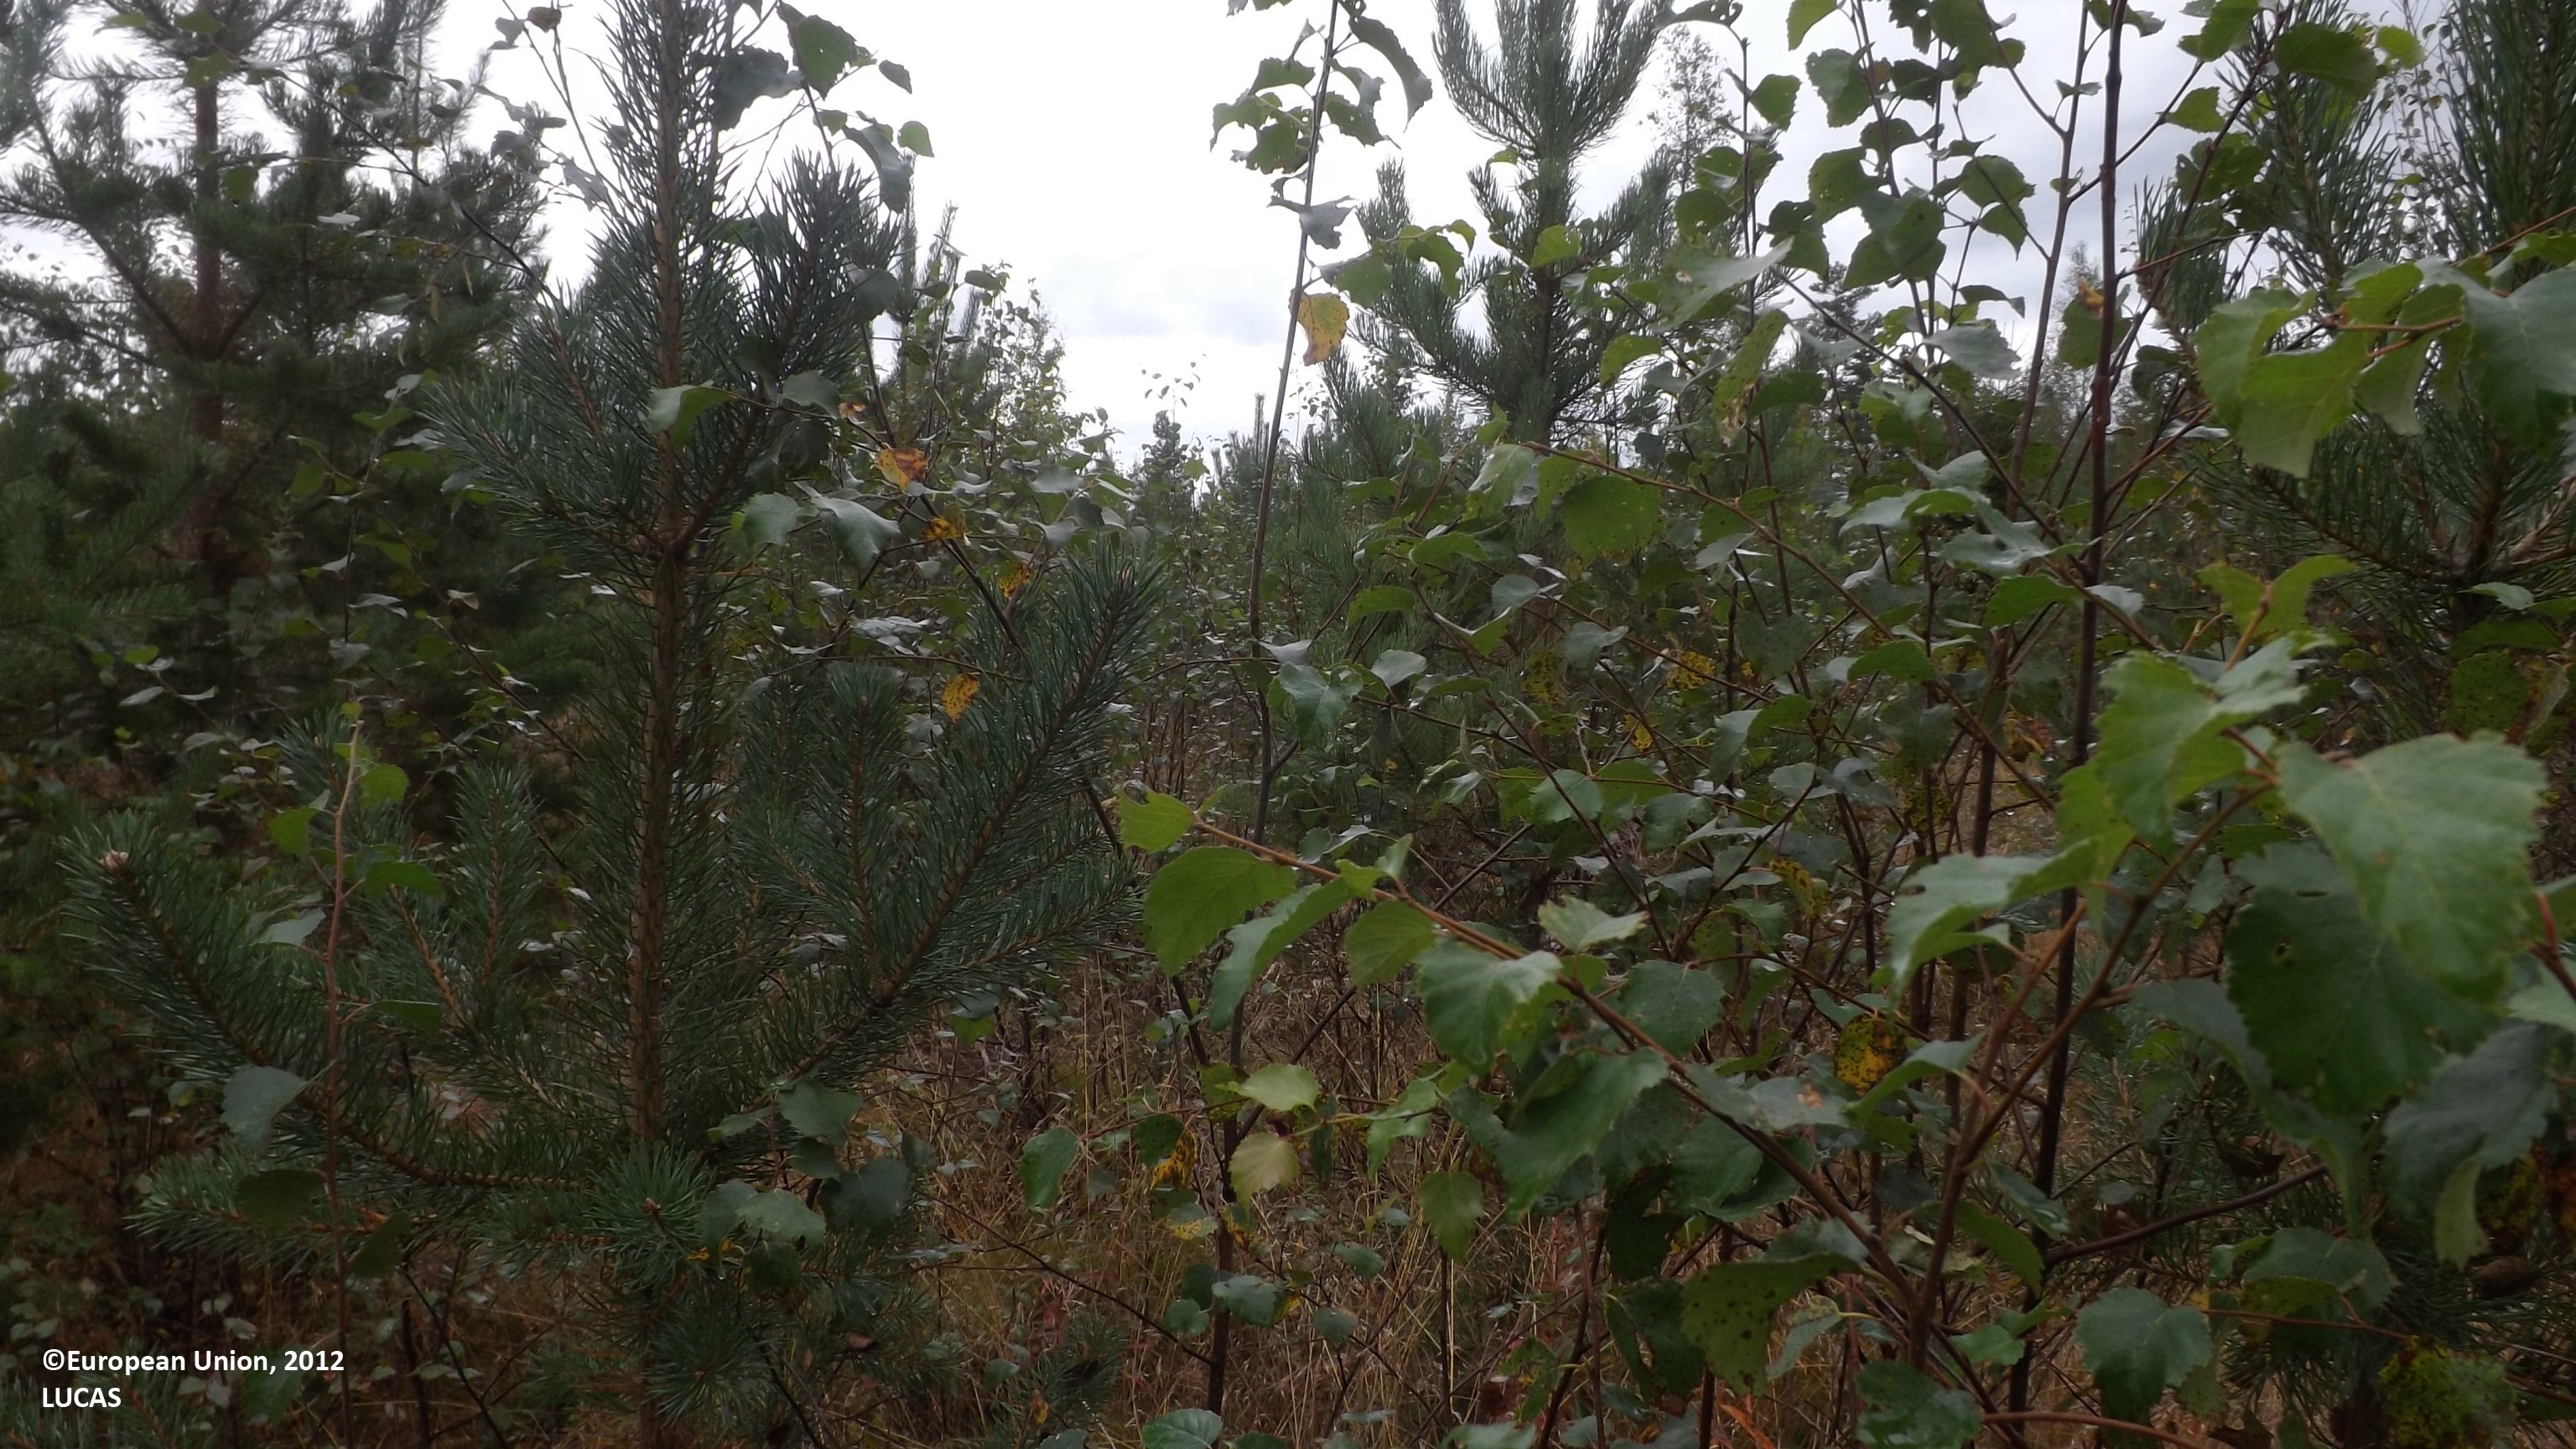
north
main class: Woodland
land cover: Pine dominated mixed woodland
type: boreal forest
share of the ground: 25 - 50 %
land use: Forestry
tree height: < 5 m
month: August
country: FI
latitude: 63.9499
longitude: 23.8809
